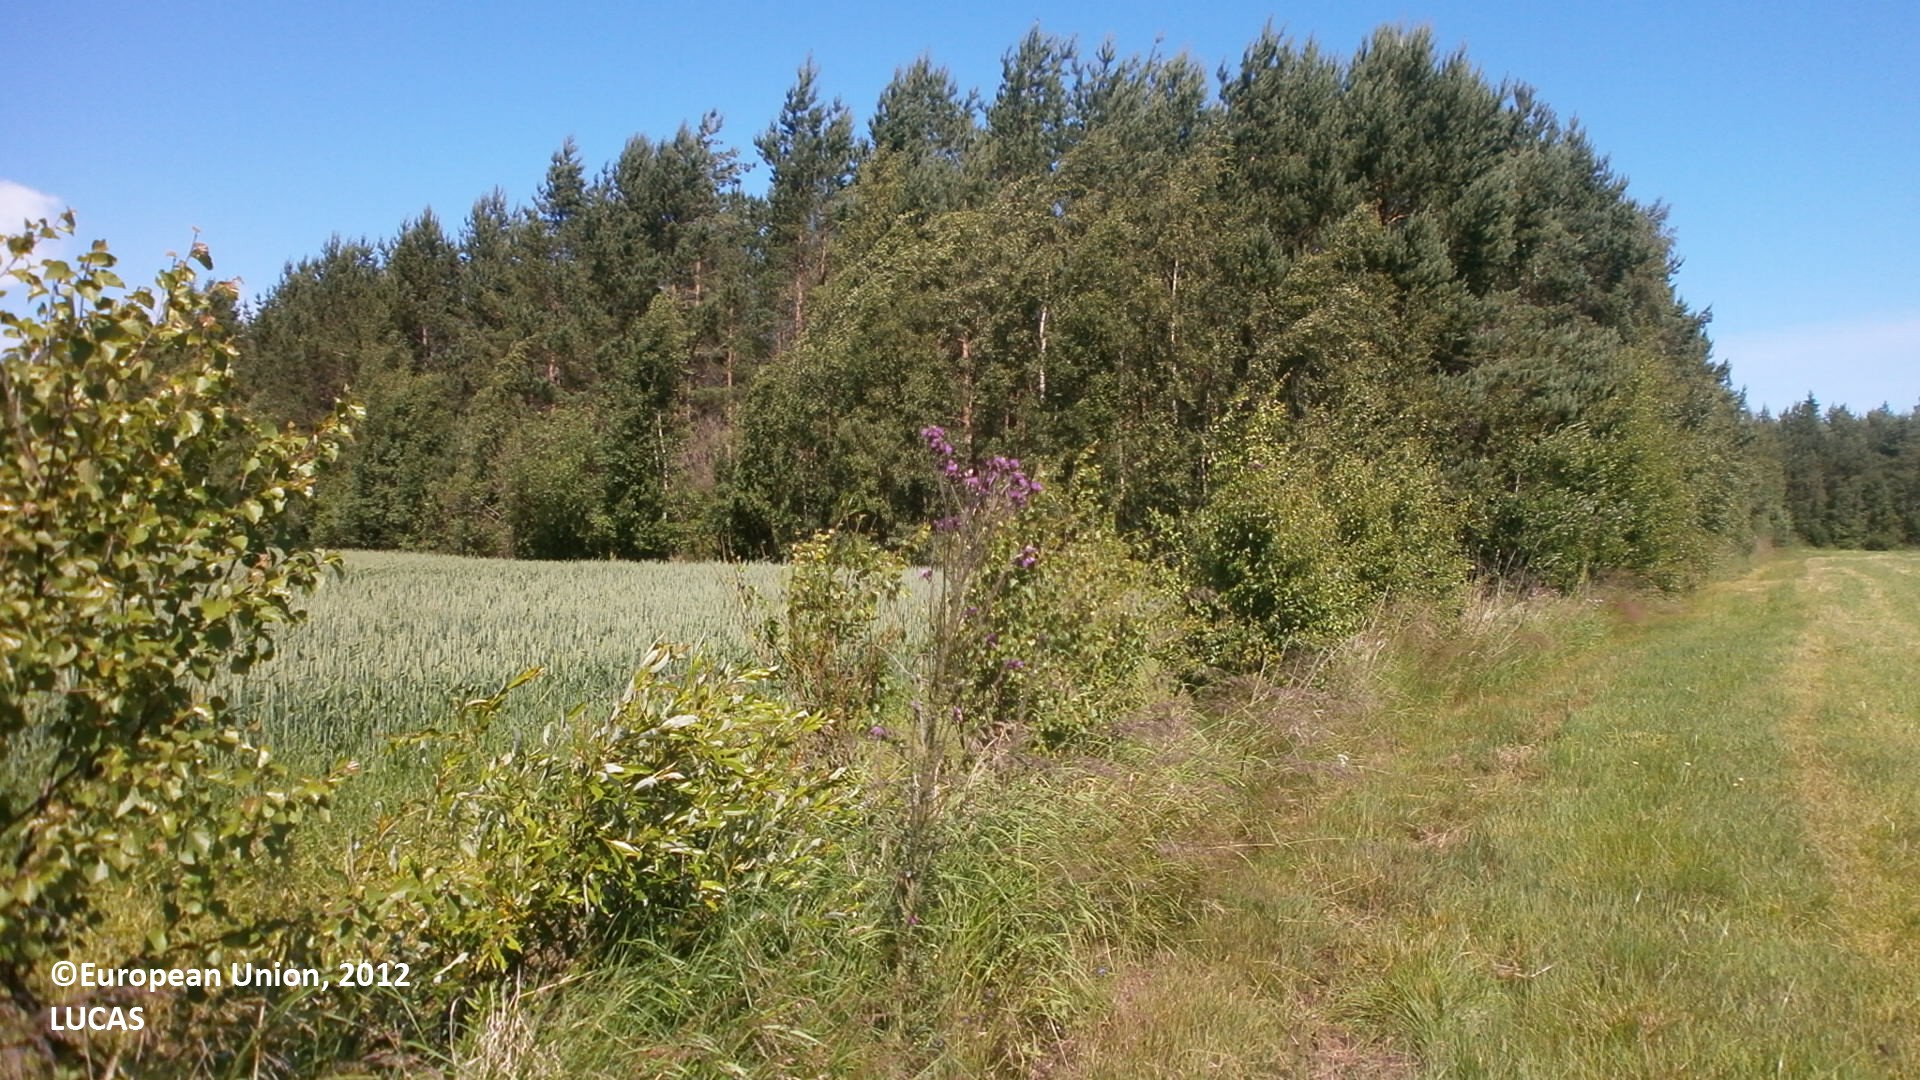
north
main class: Cropland
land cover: Temporary grasslands
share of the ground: > 75 %
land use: Agriculture (excluding fallow land and kitchen gardens)
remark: Harvested field
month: July
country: FI
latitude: 64.3763
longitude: 24.0516
